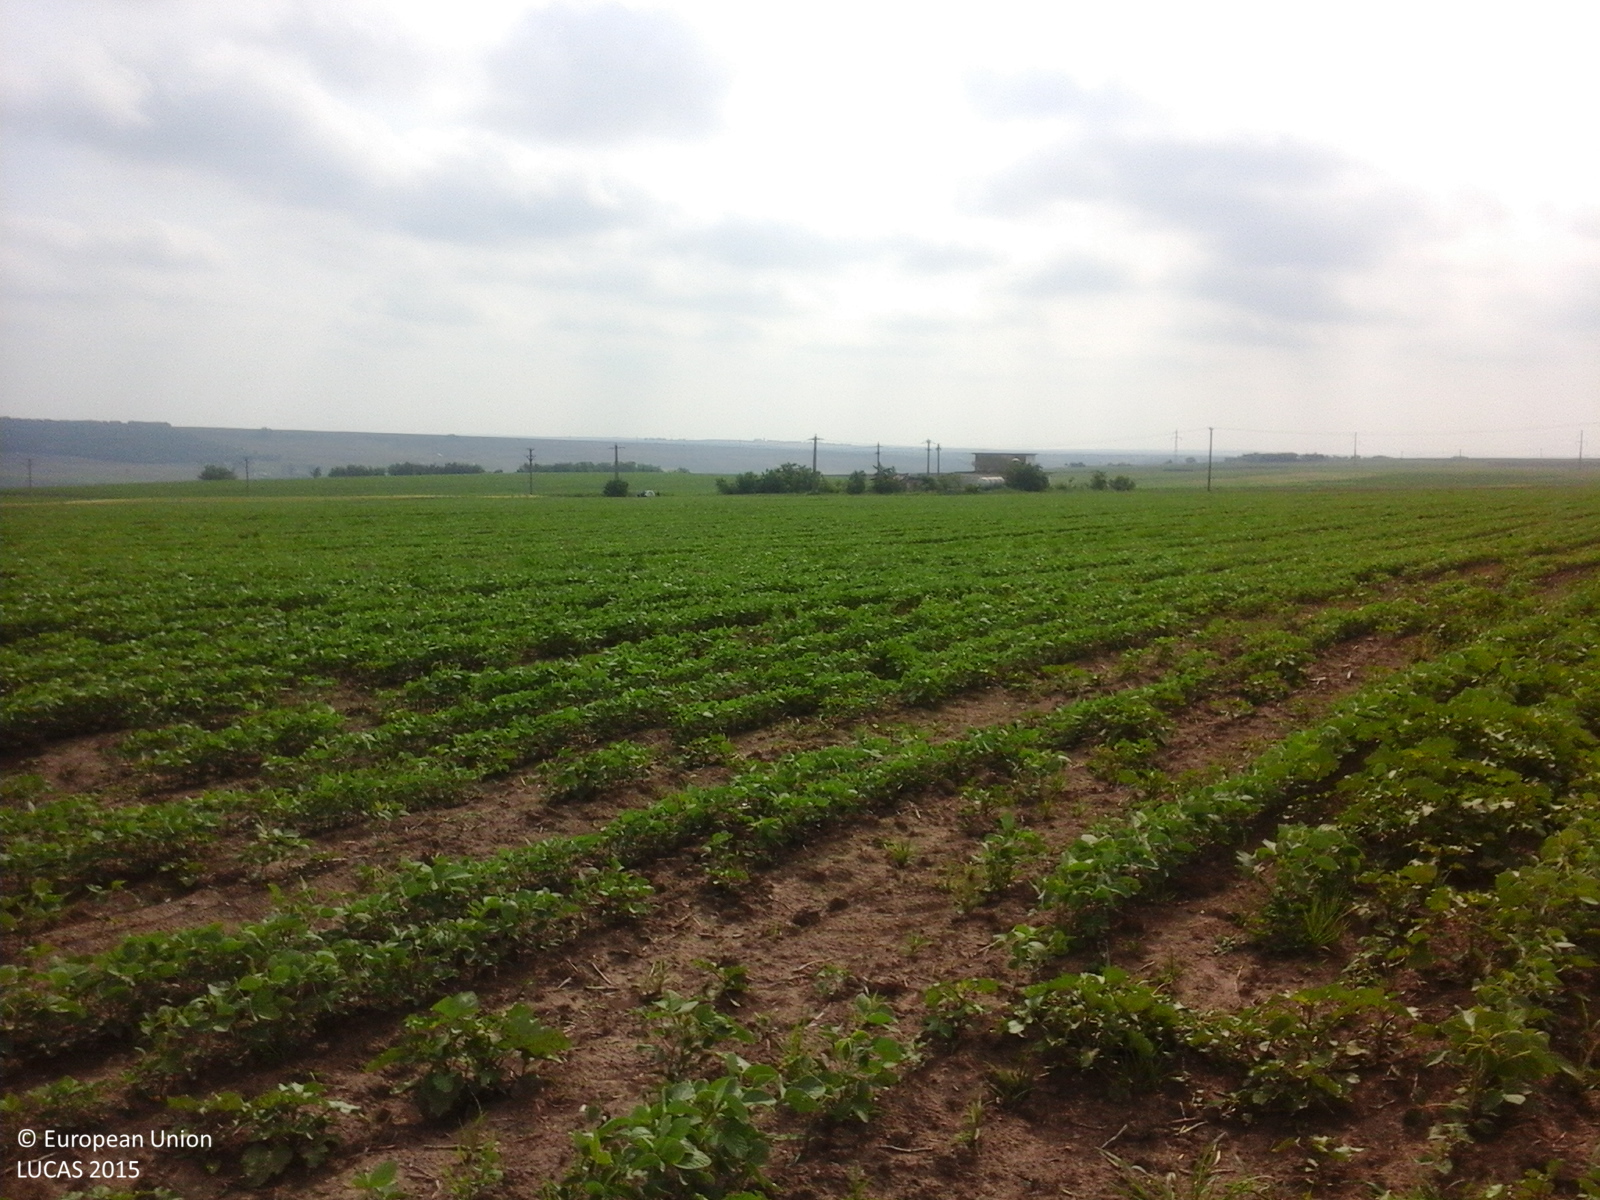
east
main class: Cropland
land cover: Soya
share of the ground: 50 - 75 %
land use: Agriculture (excluding fallow land and kitchen gardens)
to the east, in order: Soya
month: June
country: RO
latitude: 47.7754
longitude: 26.6287
